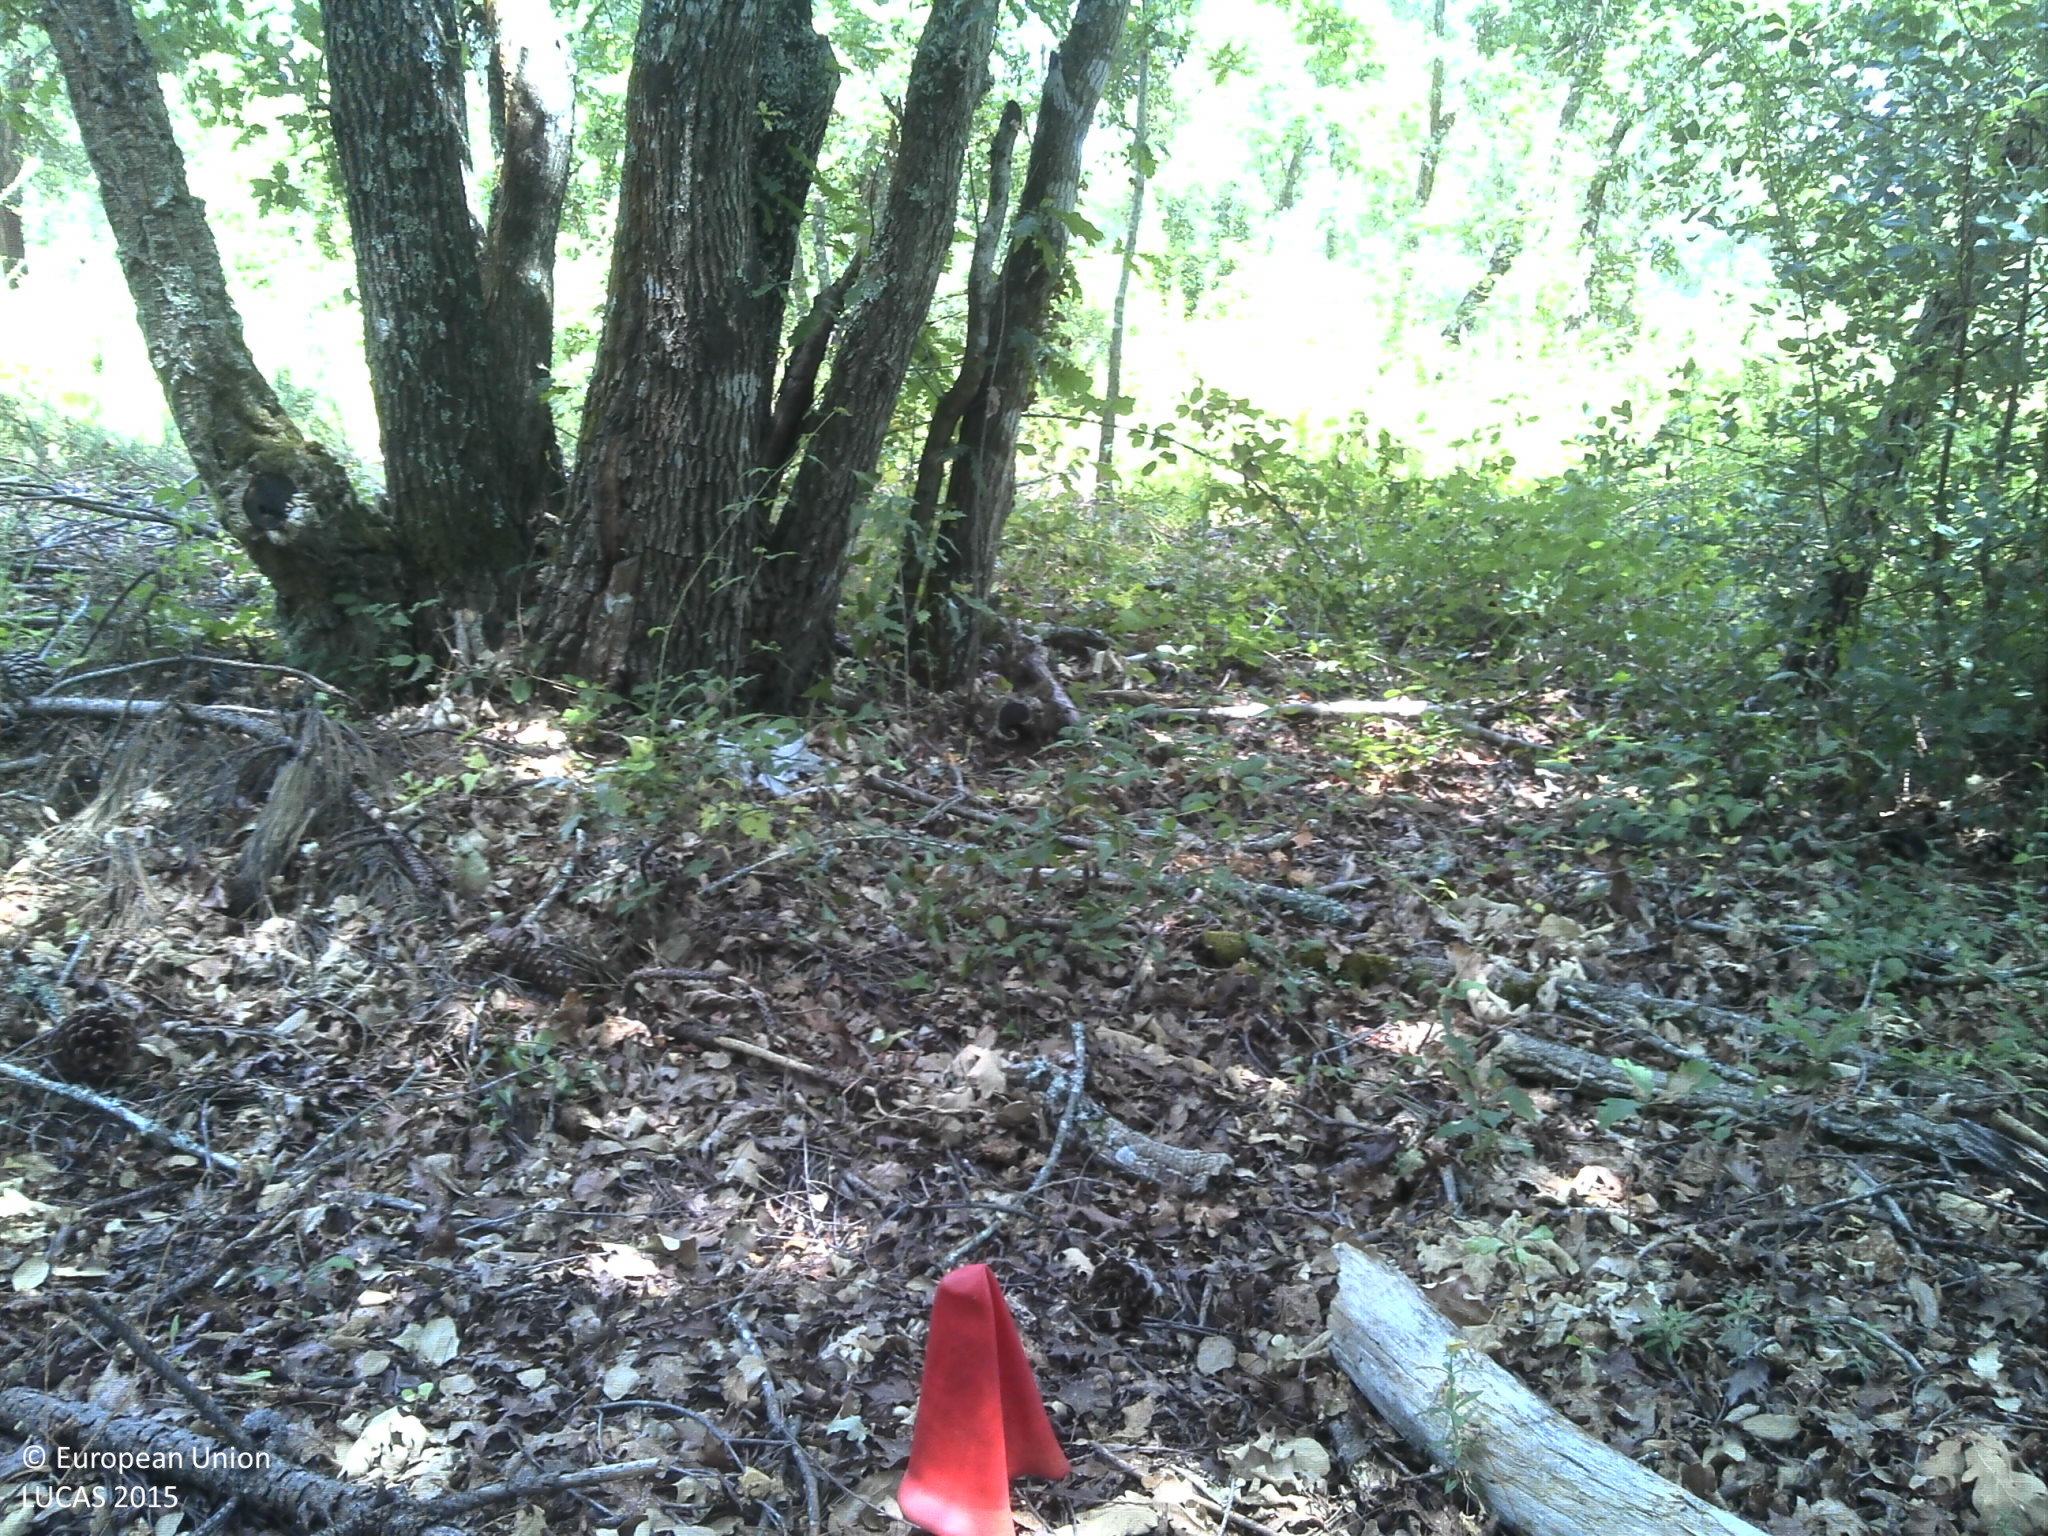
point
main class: Woodland
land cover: Broadleaved woodland
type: thermophilous deciduous forest
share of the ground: 50 - 75 %
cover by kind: broadleaved forest trees 75 %, unconsolidated bare surface 15 %, shrubs 10 %
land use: Semi-natural and natural areas not in use
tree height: > 5 m
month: July
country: PT
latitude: 40.2244
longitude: -8.2350
